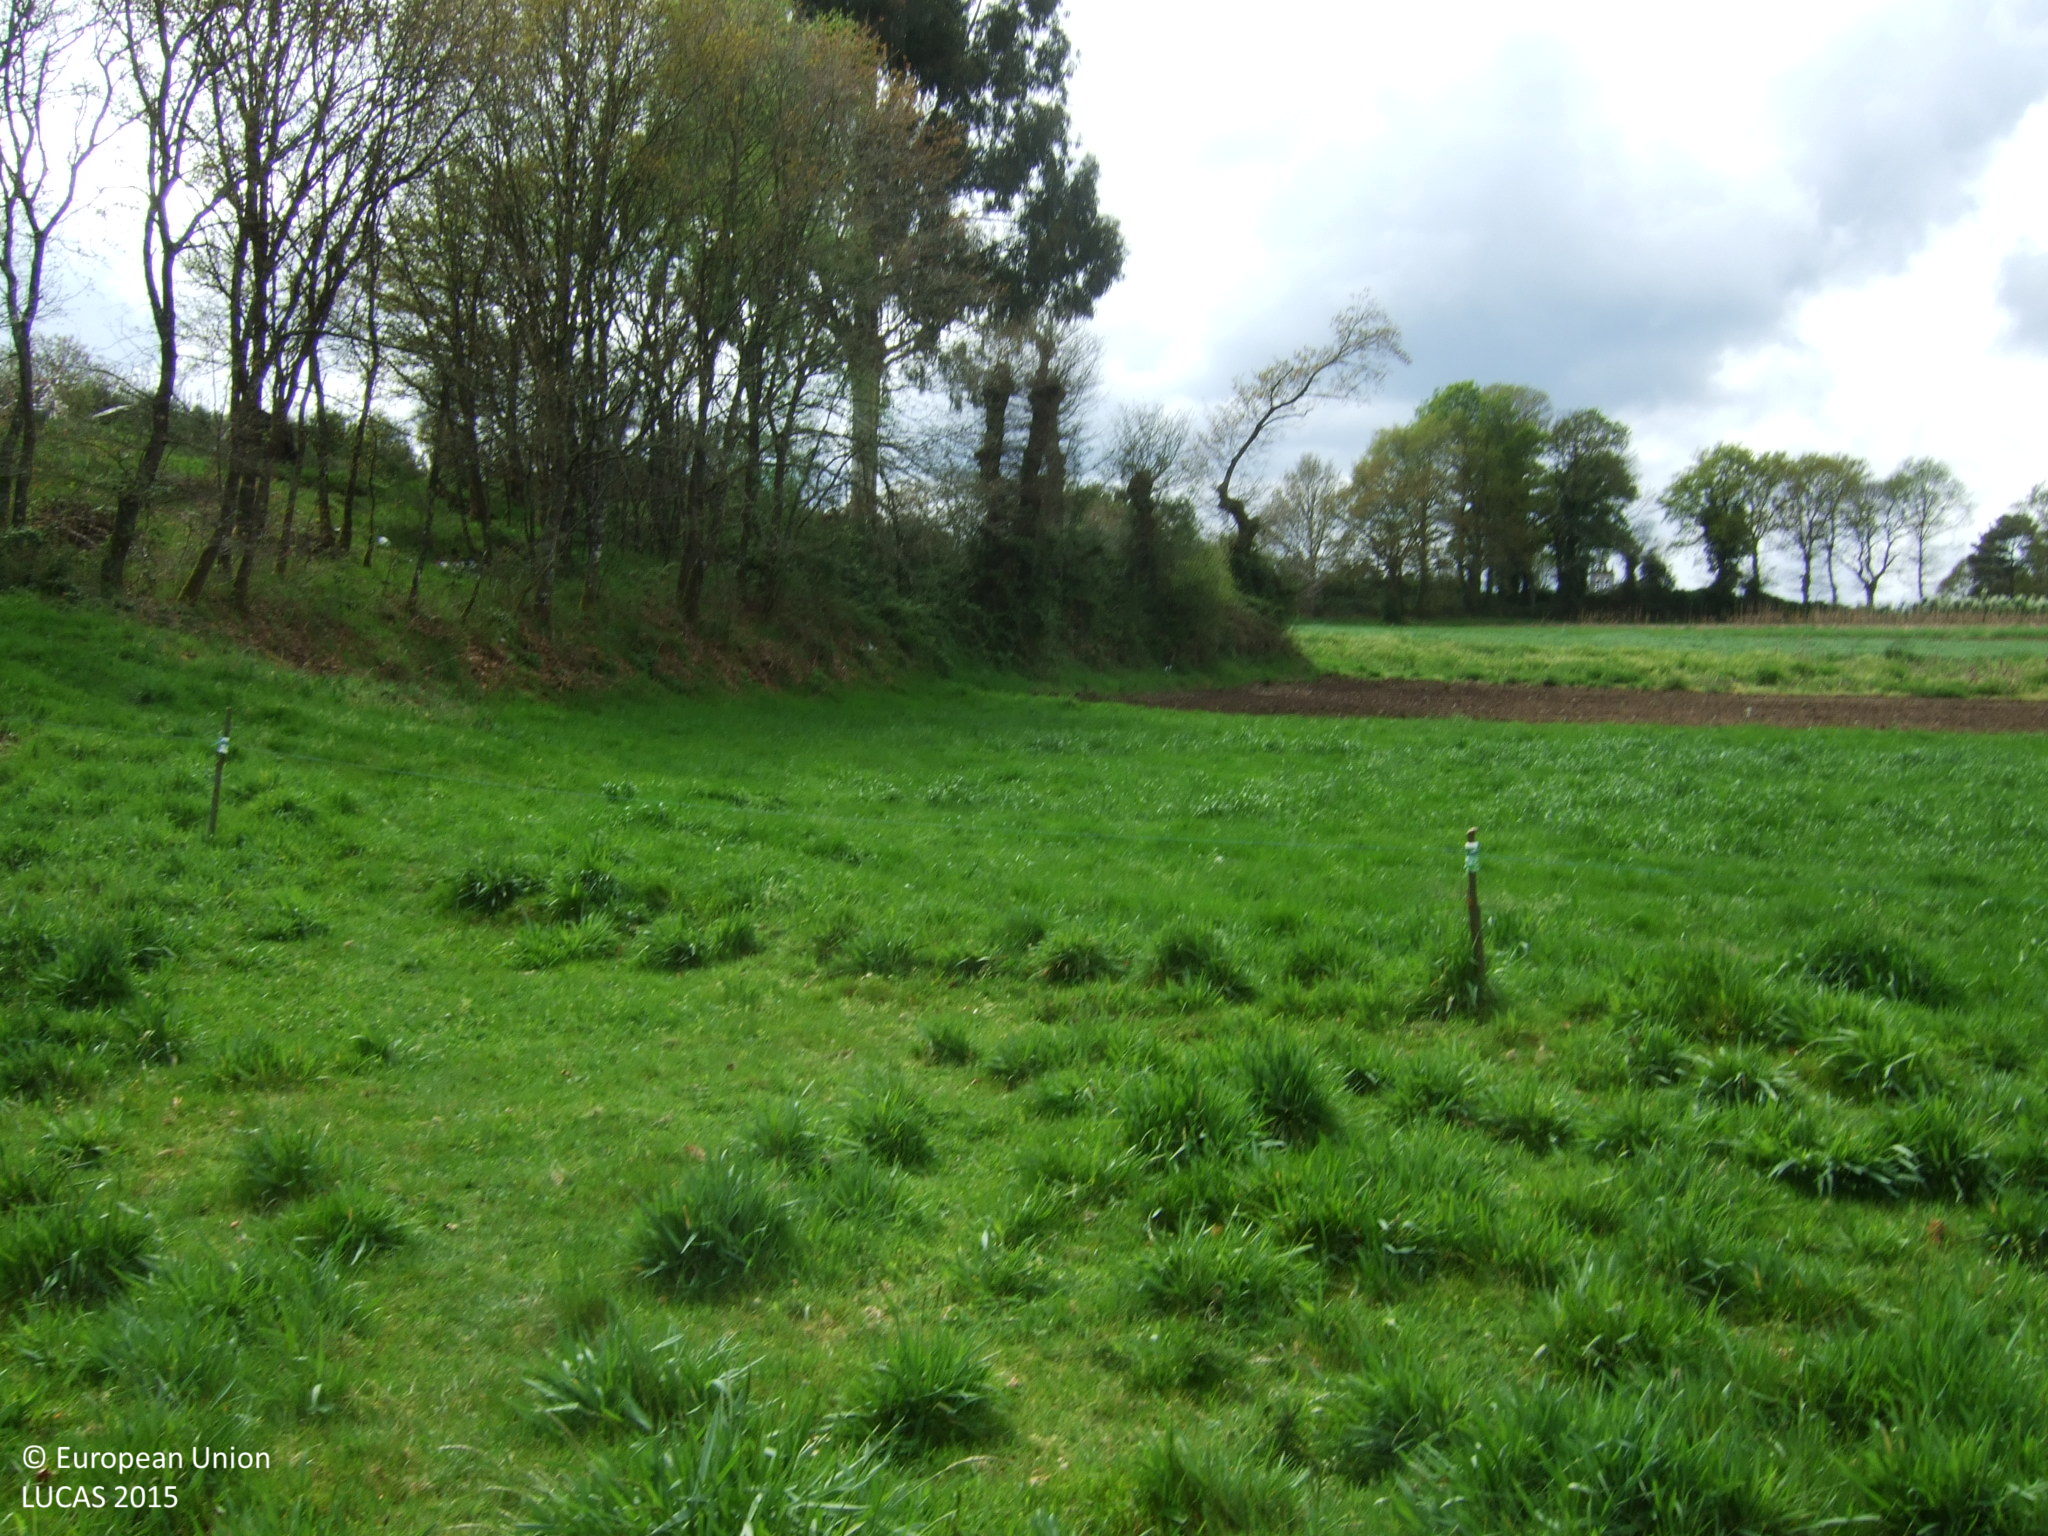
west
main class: Grassland
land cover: Grassland without tree/shrub cover
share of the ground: > 75 %
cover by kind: herbaceous plants 100 %
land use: Agriculture (excluding fallow land and kitchen gardens)
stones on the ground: < 10 %
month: April
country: ES
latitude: 43.0107
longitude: -7.8383
